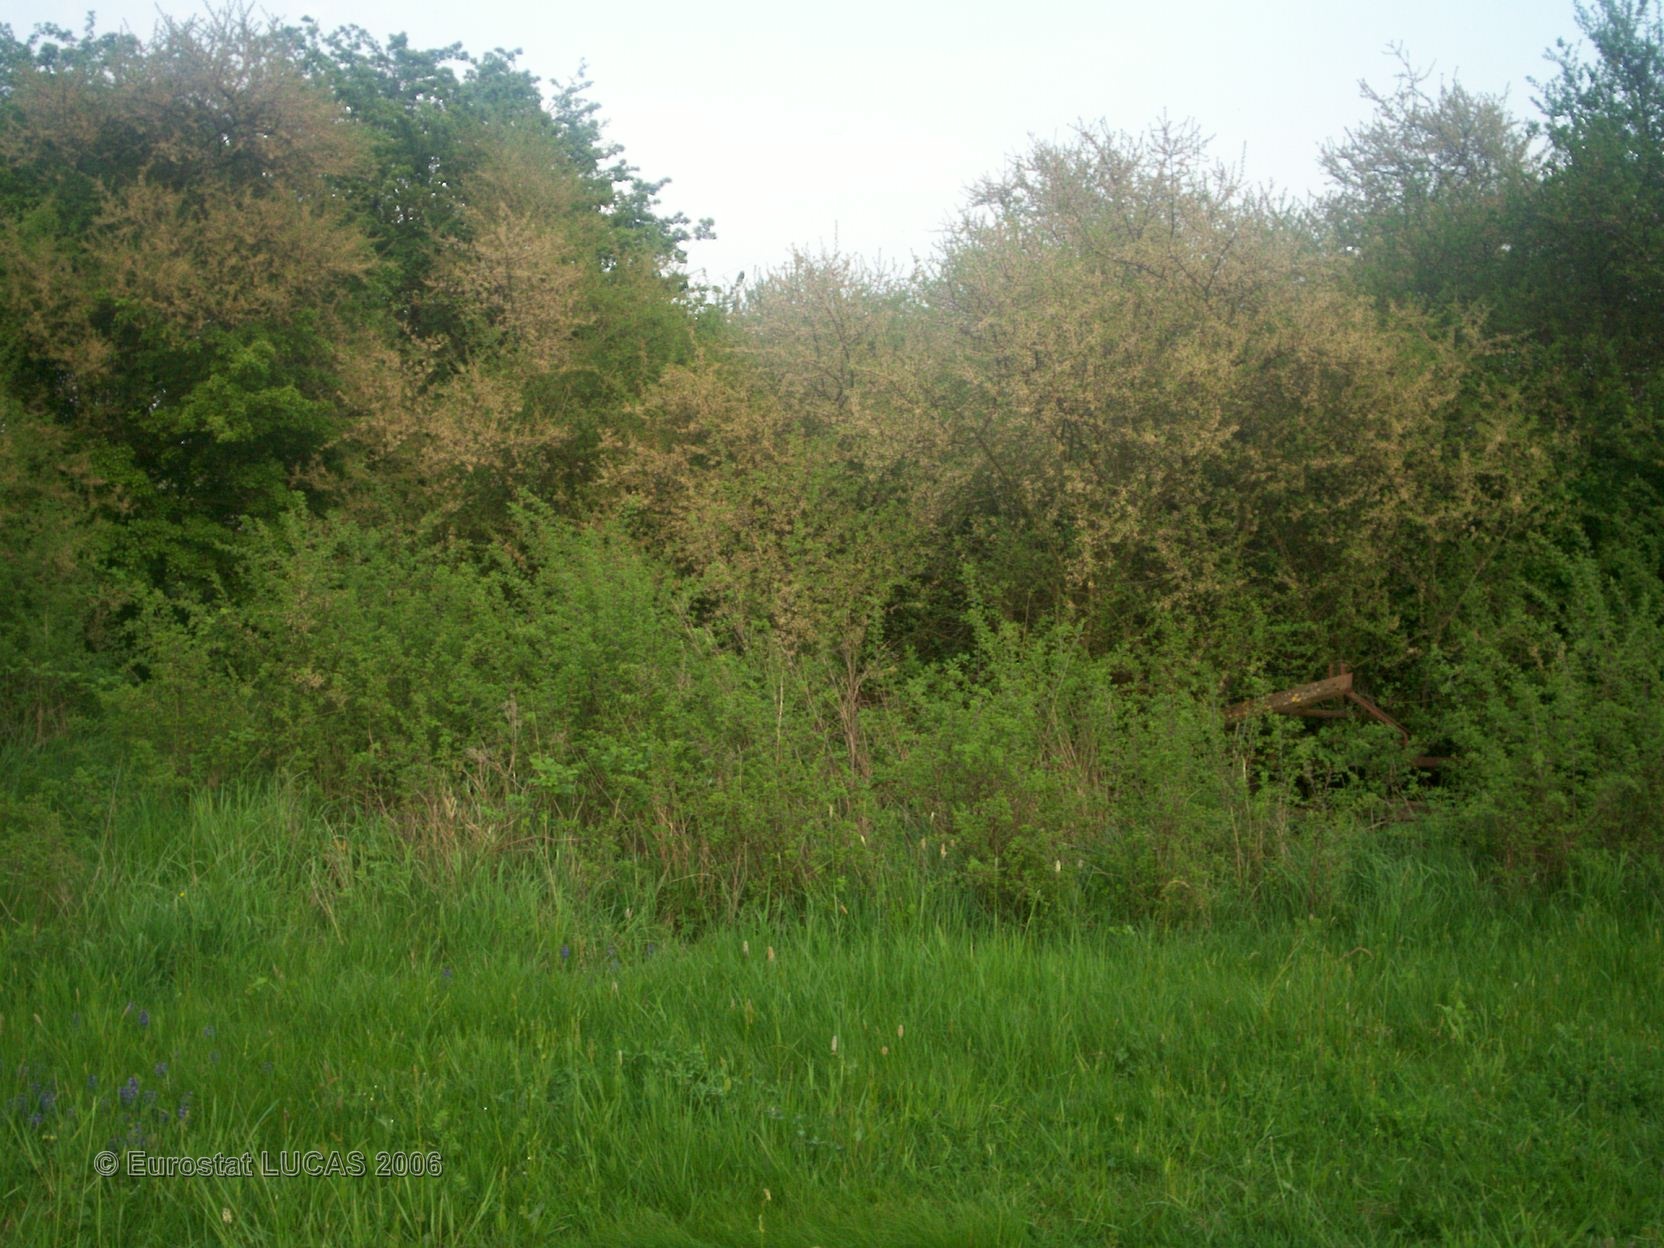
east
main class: Artificial land
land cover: Non built-up linear features
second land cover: Grassland without tree/shrub cover
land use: Road transport
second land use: Agriculture (excluding fallow land and kitchen gardens)
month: May
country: FR
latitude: 48.8127
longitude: 6.9910
